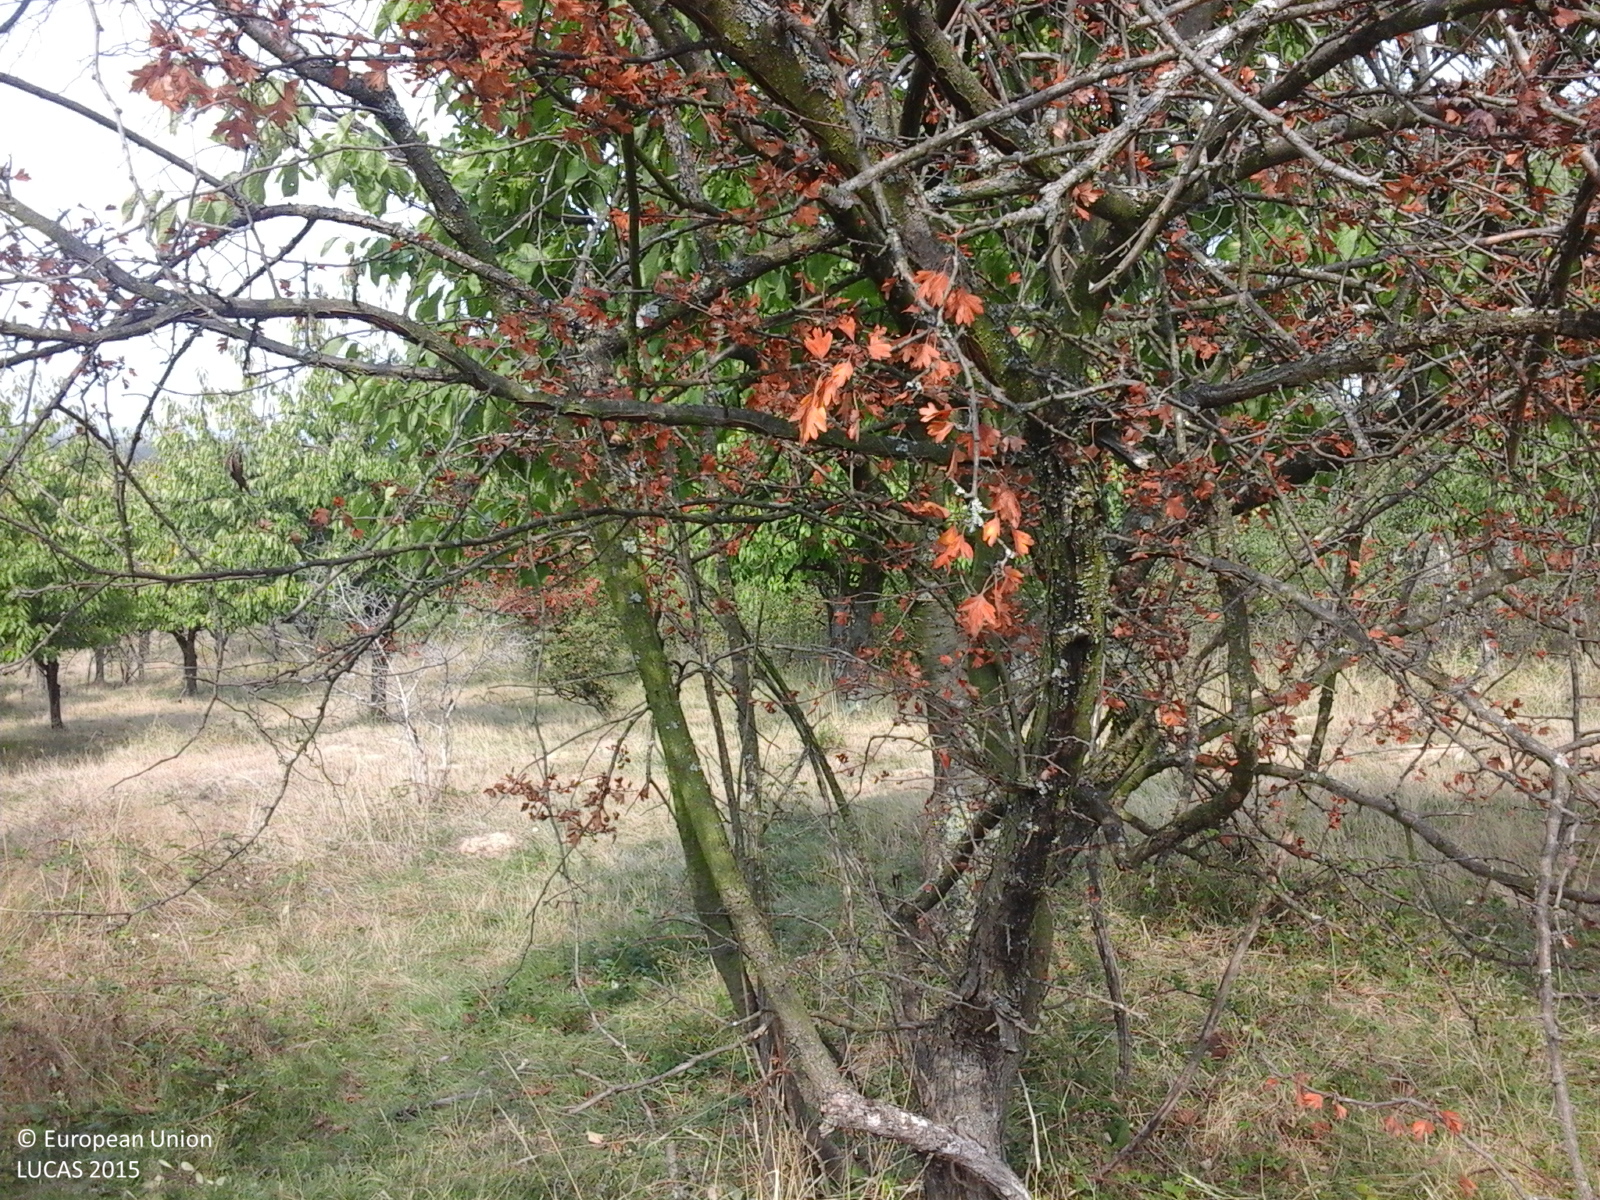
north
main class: Cropland
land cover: Cherry fruit
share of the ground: 25 - 50 %
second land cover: Grassland without tree/shrub cover
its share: > 75 %
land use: Agriculture (excluding fallow land and kitchen gardens)
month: September
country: RO
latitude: 45.5145
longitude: 22.1113
